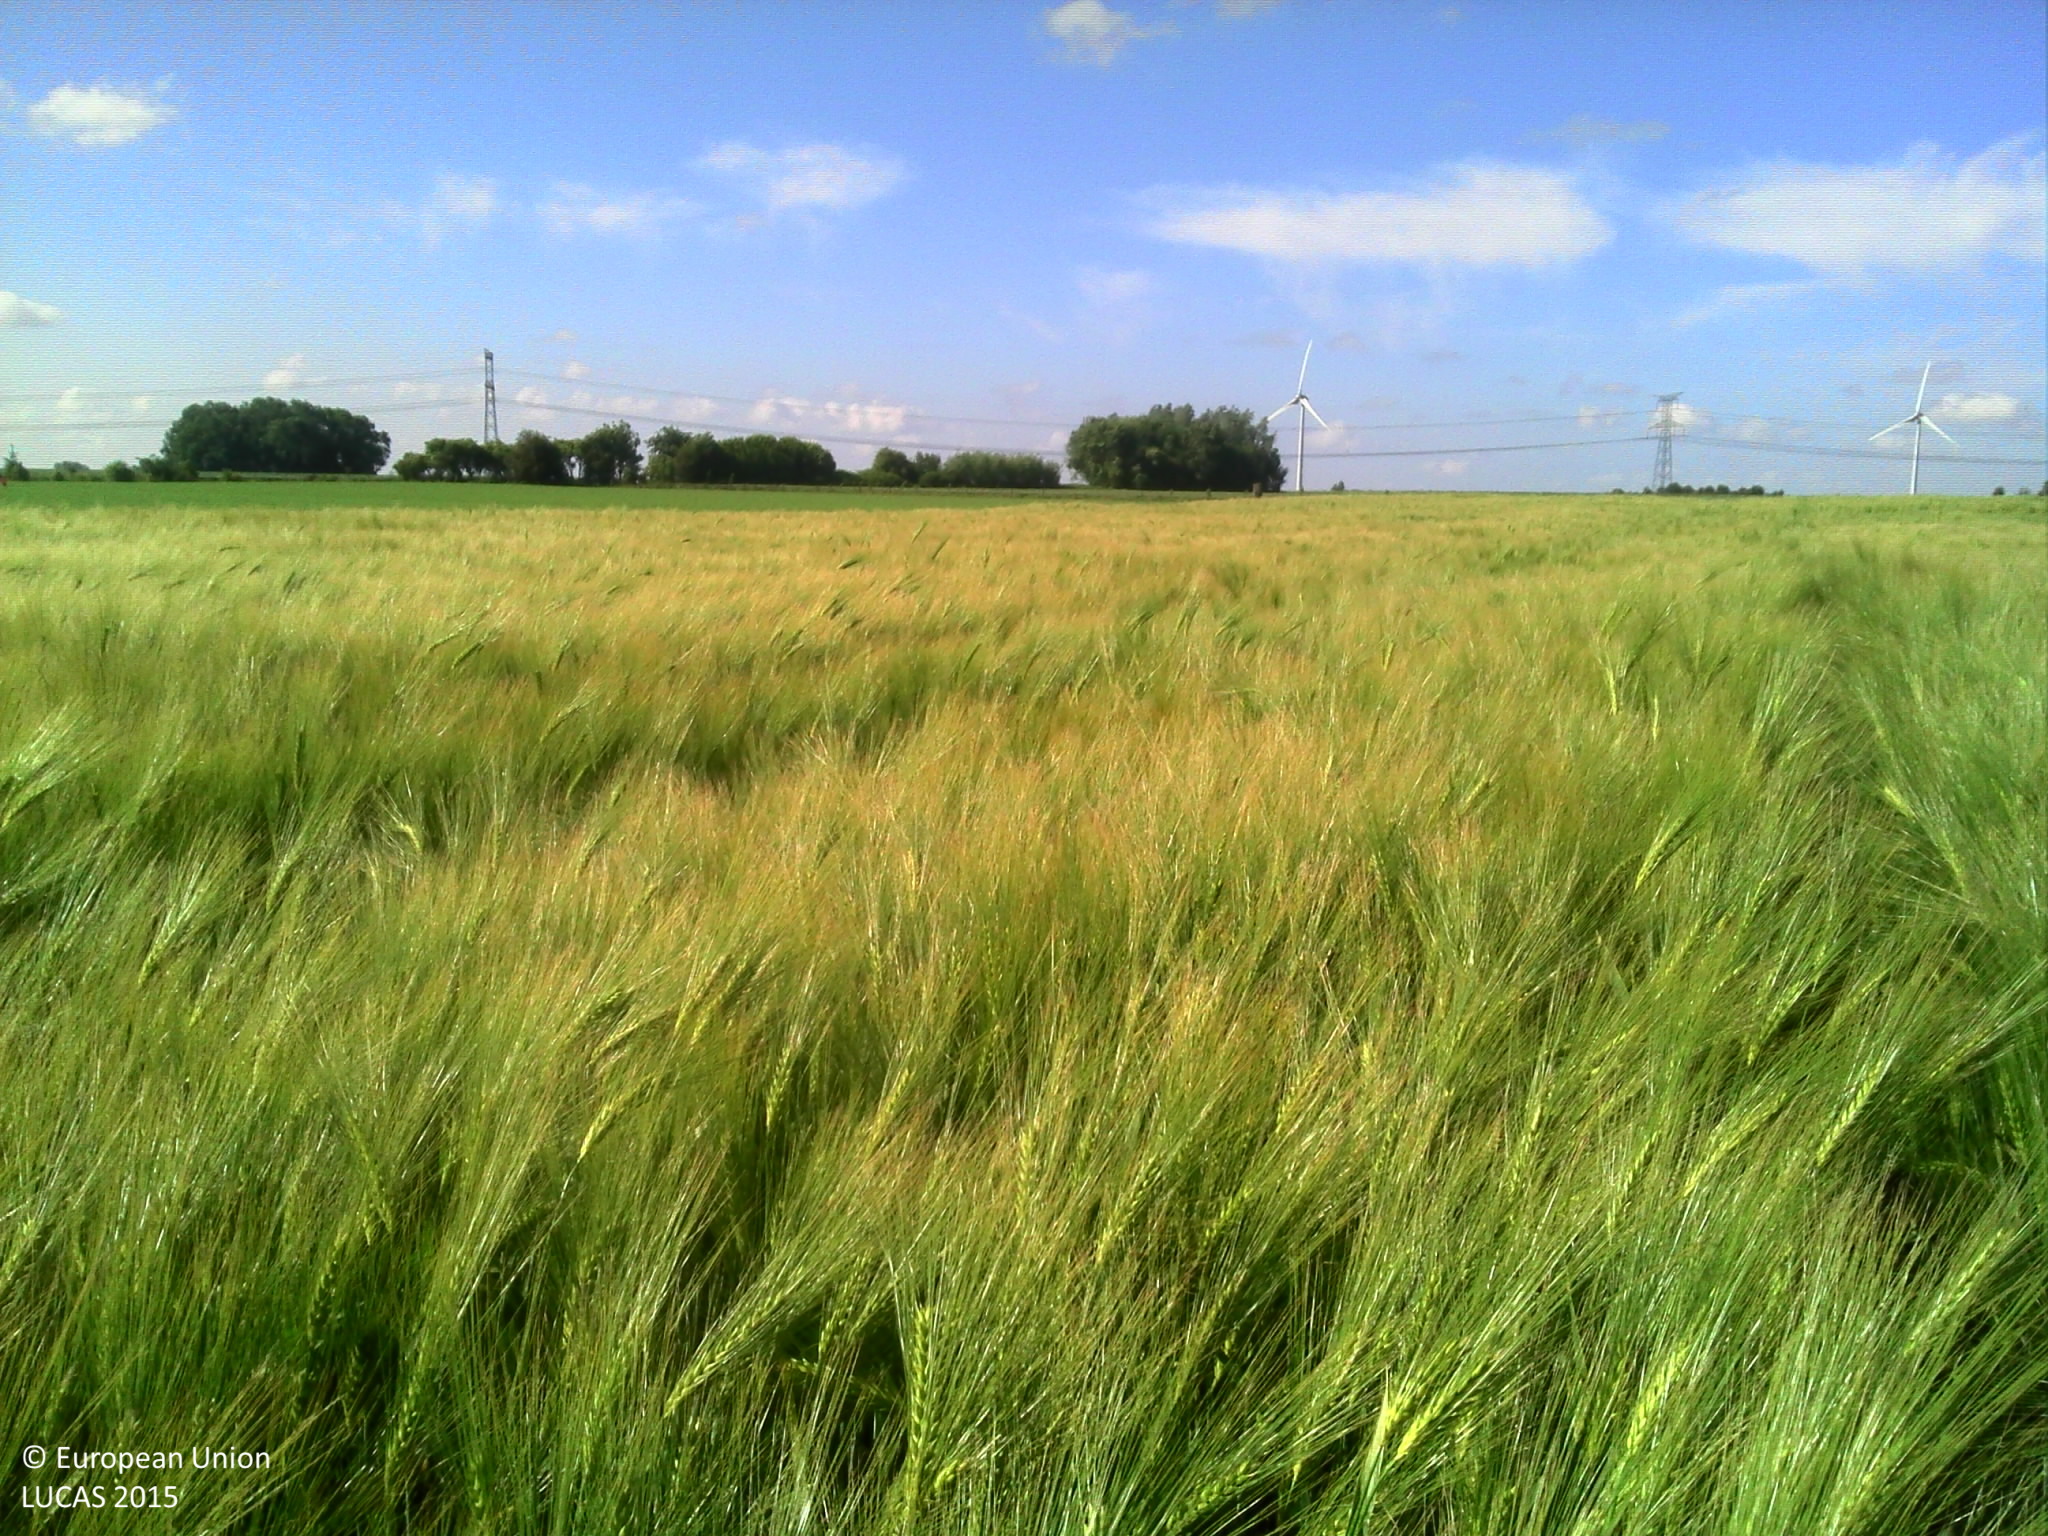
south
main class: Cropland
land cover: Barley
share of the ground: > 75 %
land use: Agriculture (excluding fallow land and kitchen gardens)
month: June
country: FR
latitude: 50.0538
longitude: 1.5877
